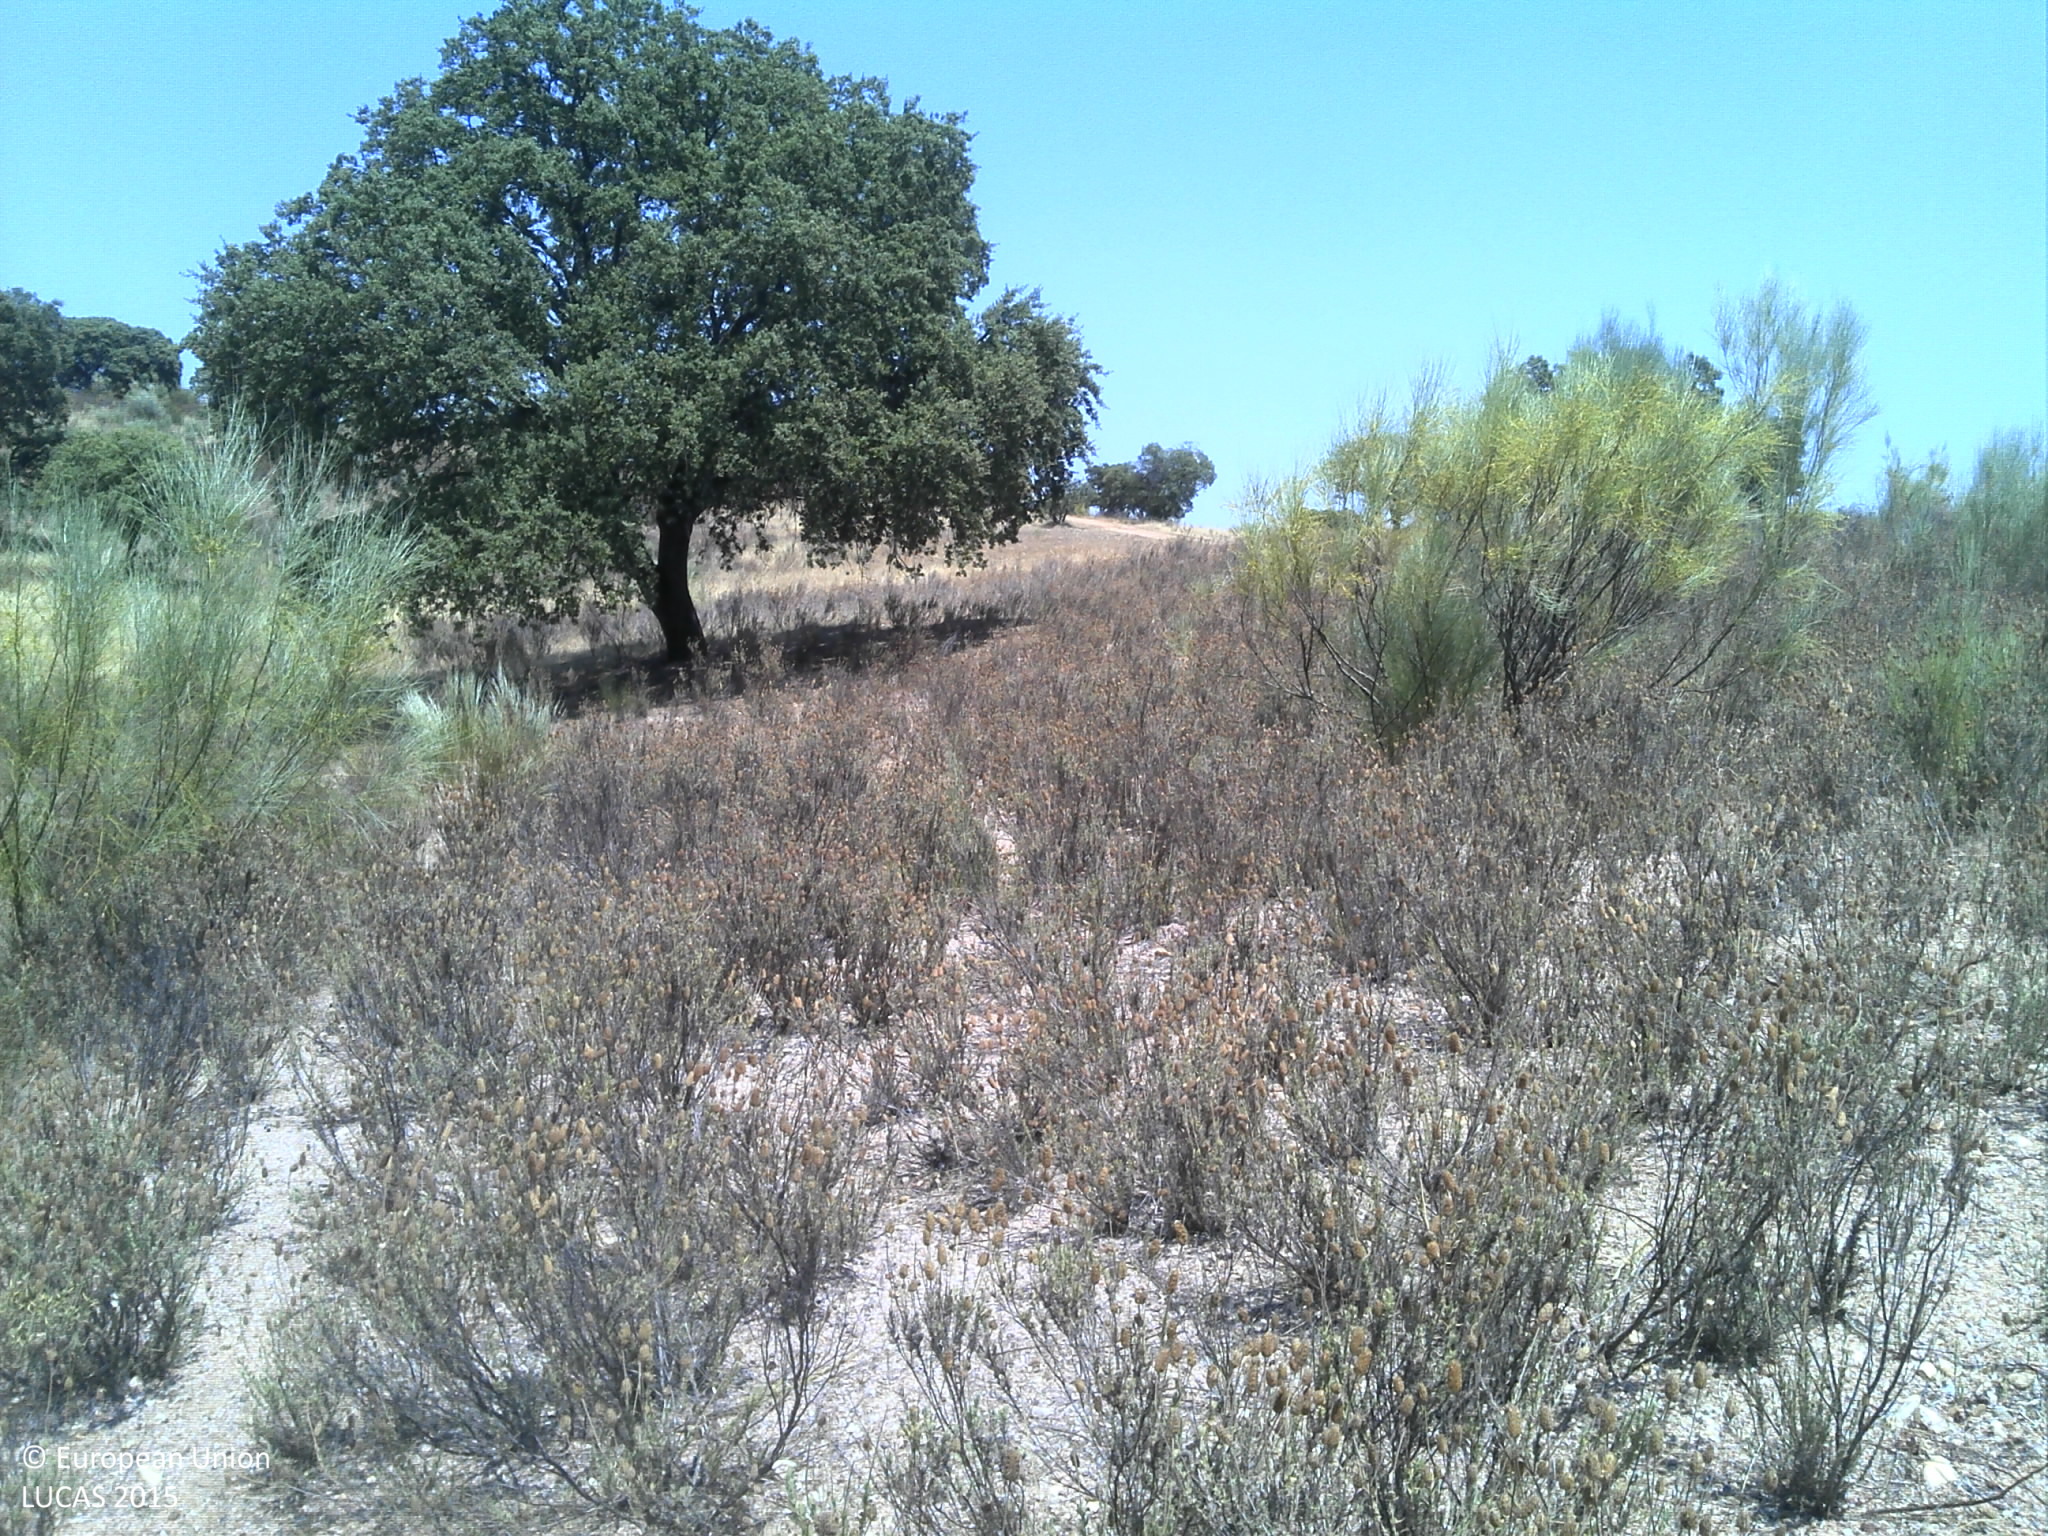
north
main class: Woodland
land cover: Broadleaved woodland
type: broadleaved evergreen forest
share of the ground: 25 - 50 %
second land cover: Shrubland without tree cover
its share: 25 - 50 %
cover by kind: broadleaved forest trees 30 %, shrubs 30 %, unconsolidated bare surface 20 %, herbaceous plants 15 %
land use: Forestry
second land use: Agriculture (excluding fallow land and kitchen gardens)
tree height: > 5 m
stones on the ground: 10 - 25 %
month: June
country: PT
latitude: 39.7521
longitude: -7.1888
